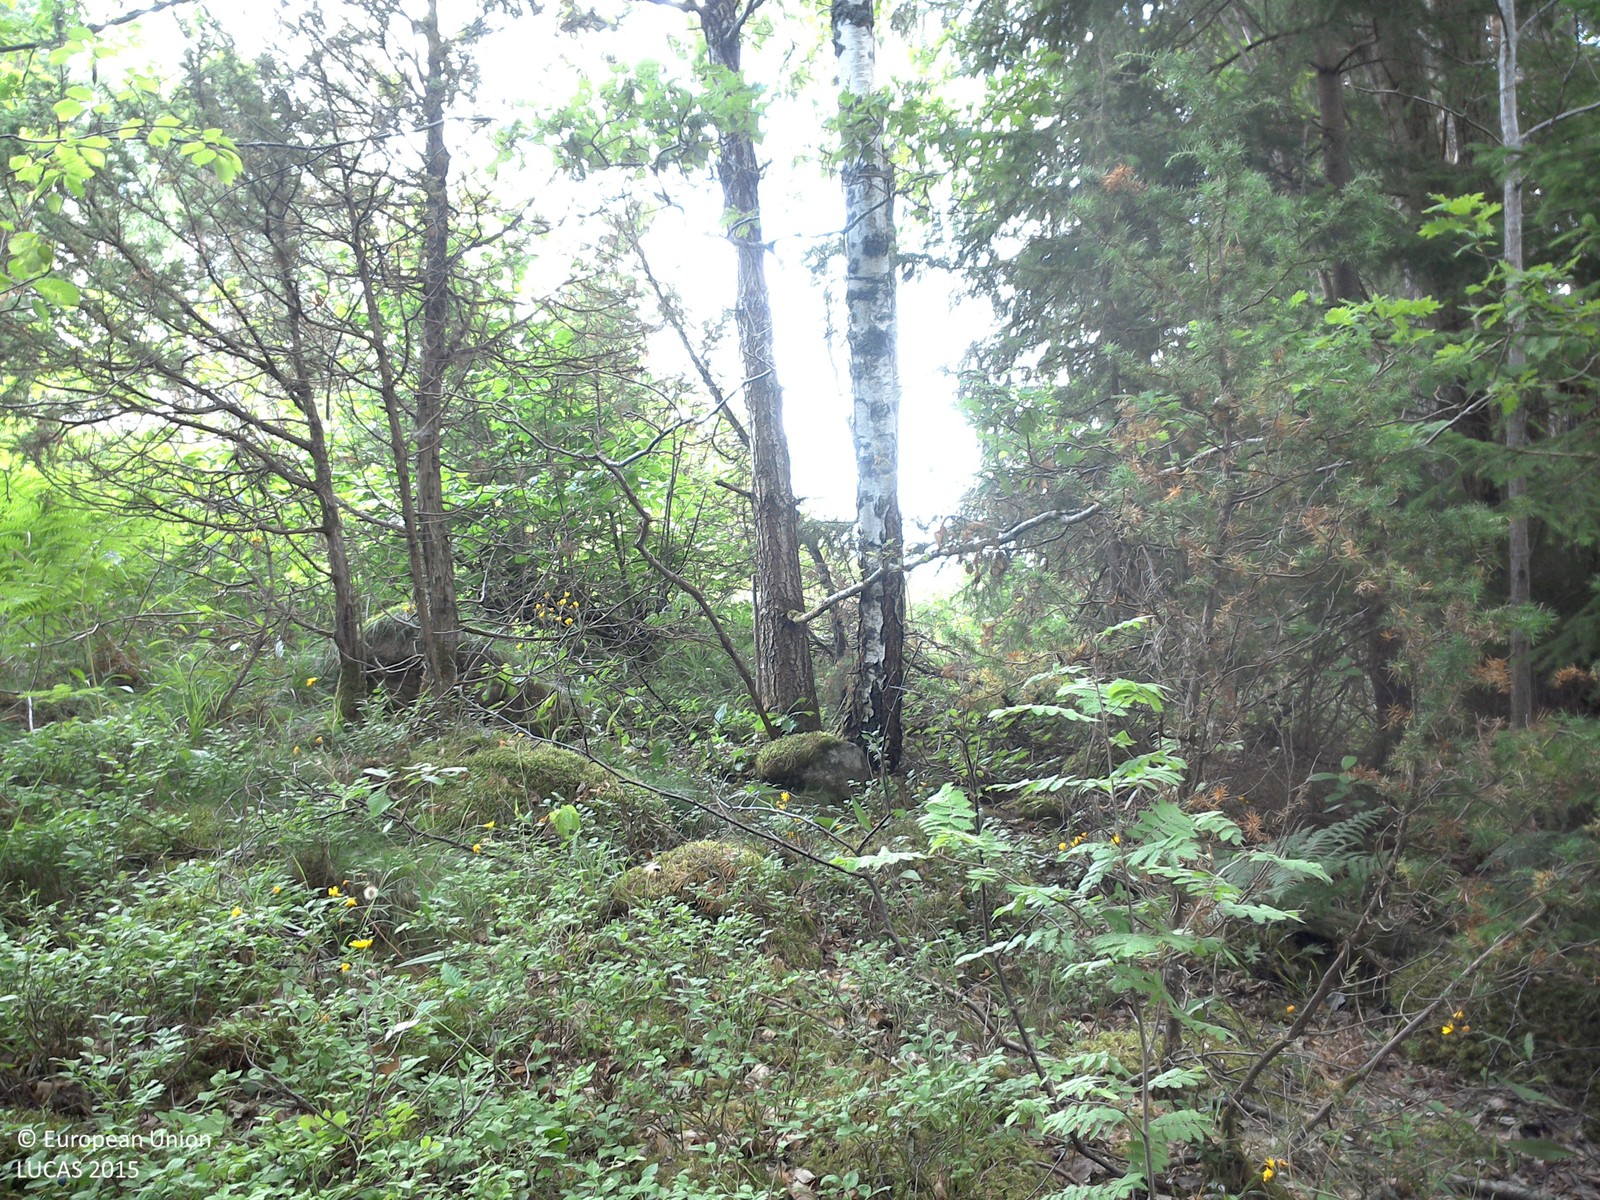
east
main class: Woodland
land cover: Spruce dominated mixed woodland
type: boreal forest
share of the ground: > 75 %
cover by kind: coniferous forest trees 50 %, broadleaved forest trees 25 %, herbaceous plants 15 %, lichens and mosses 10 %
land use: Forestry
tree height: > 5 m
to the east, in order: Spruce dominated mixed woodland; Electric lines; Grass margins; Paved roads, cycling and walking lanes; Electric lines; Paved roads, cycling and walking lanes; Grass margins; Broadleaved woodland
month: July
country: SE
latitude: 57.9042
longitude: 16.0209
